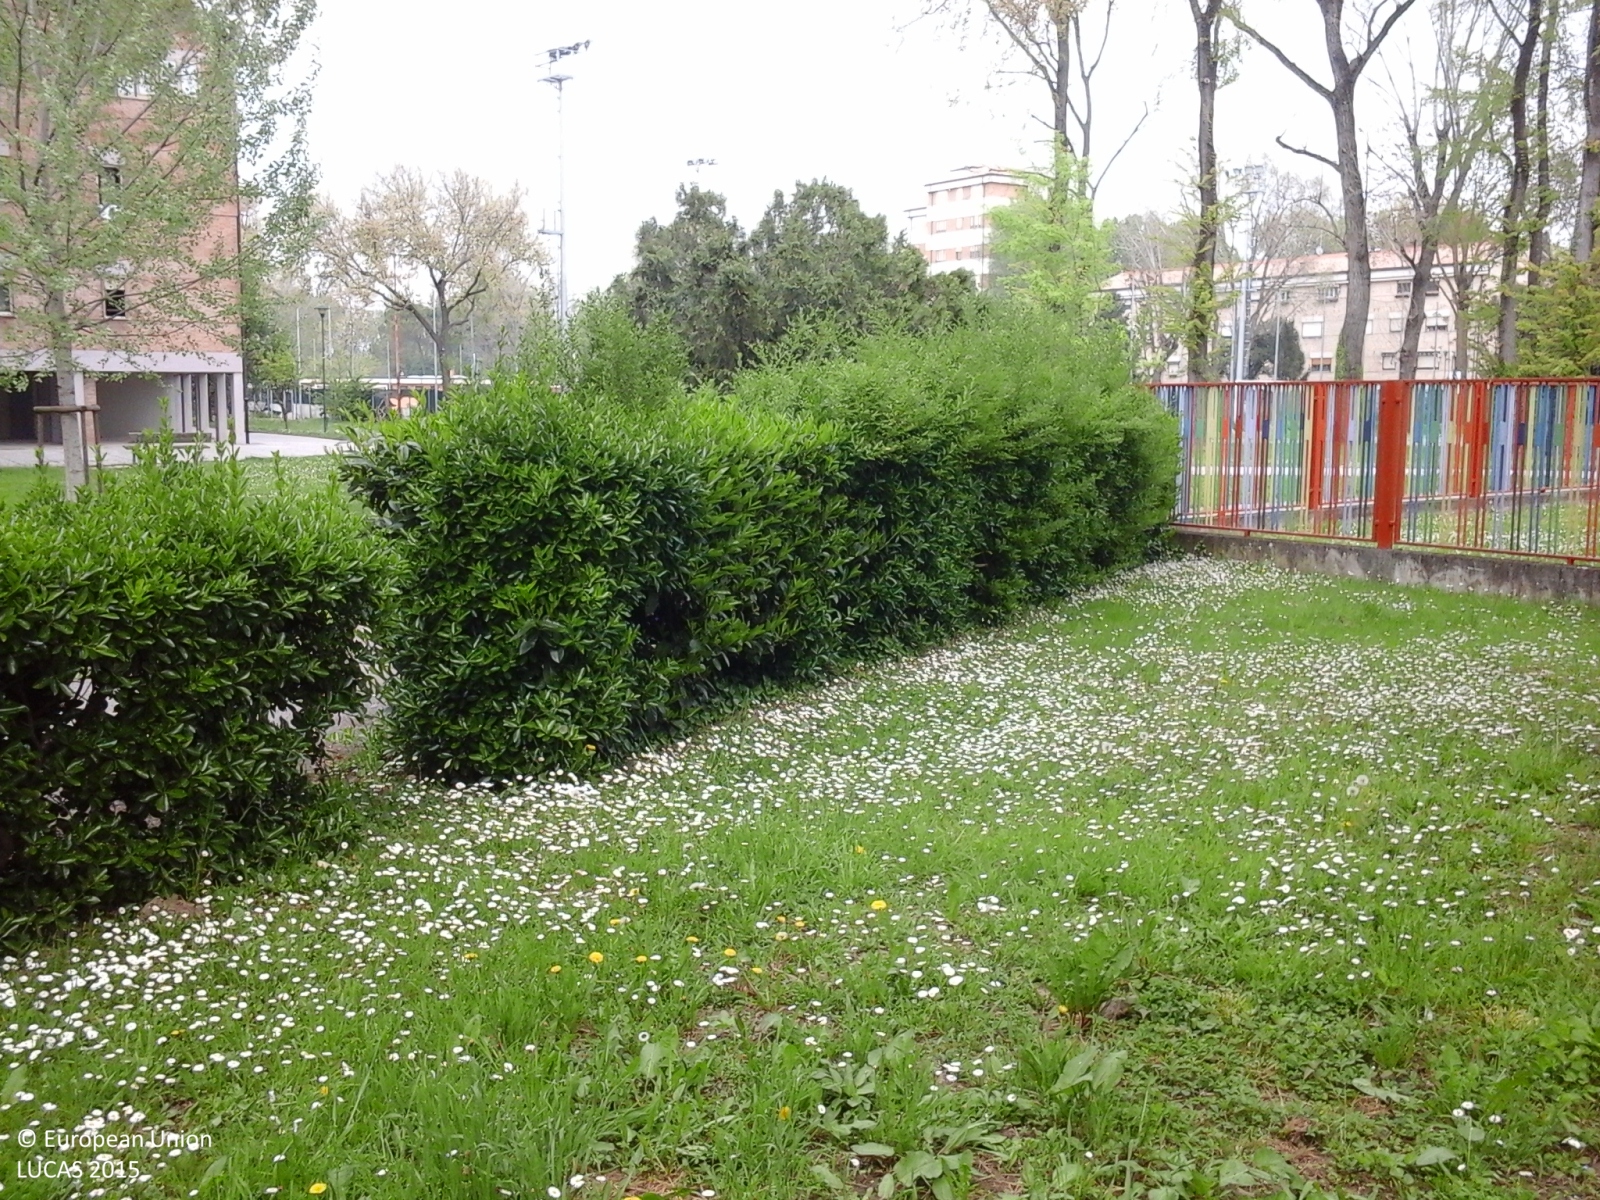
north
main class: Woodland
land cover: Broadleaved woodland
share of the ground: 50 - 75 %
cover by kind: broadleaved forest trees 70 %, herbaceous plants 30 %
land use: Residential
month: April
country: IT
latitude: 45.4797
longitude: 12.2864
